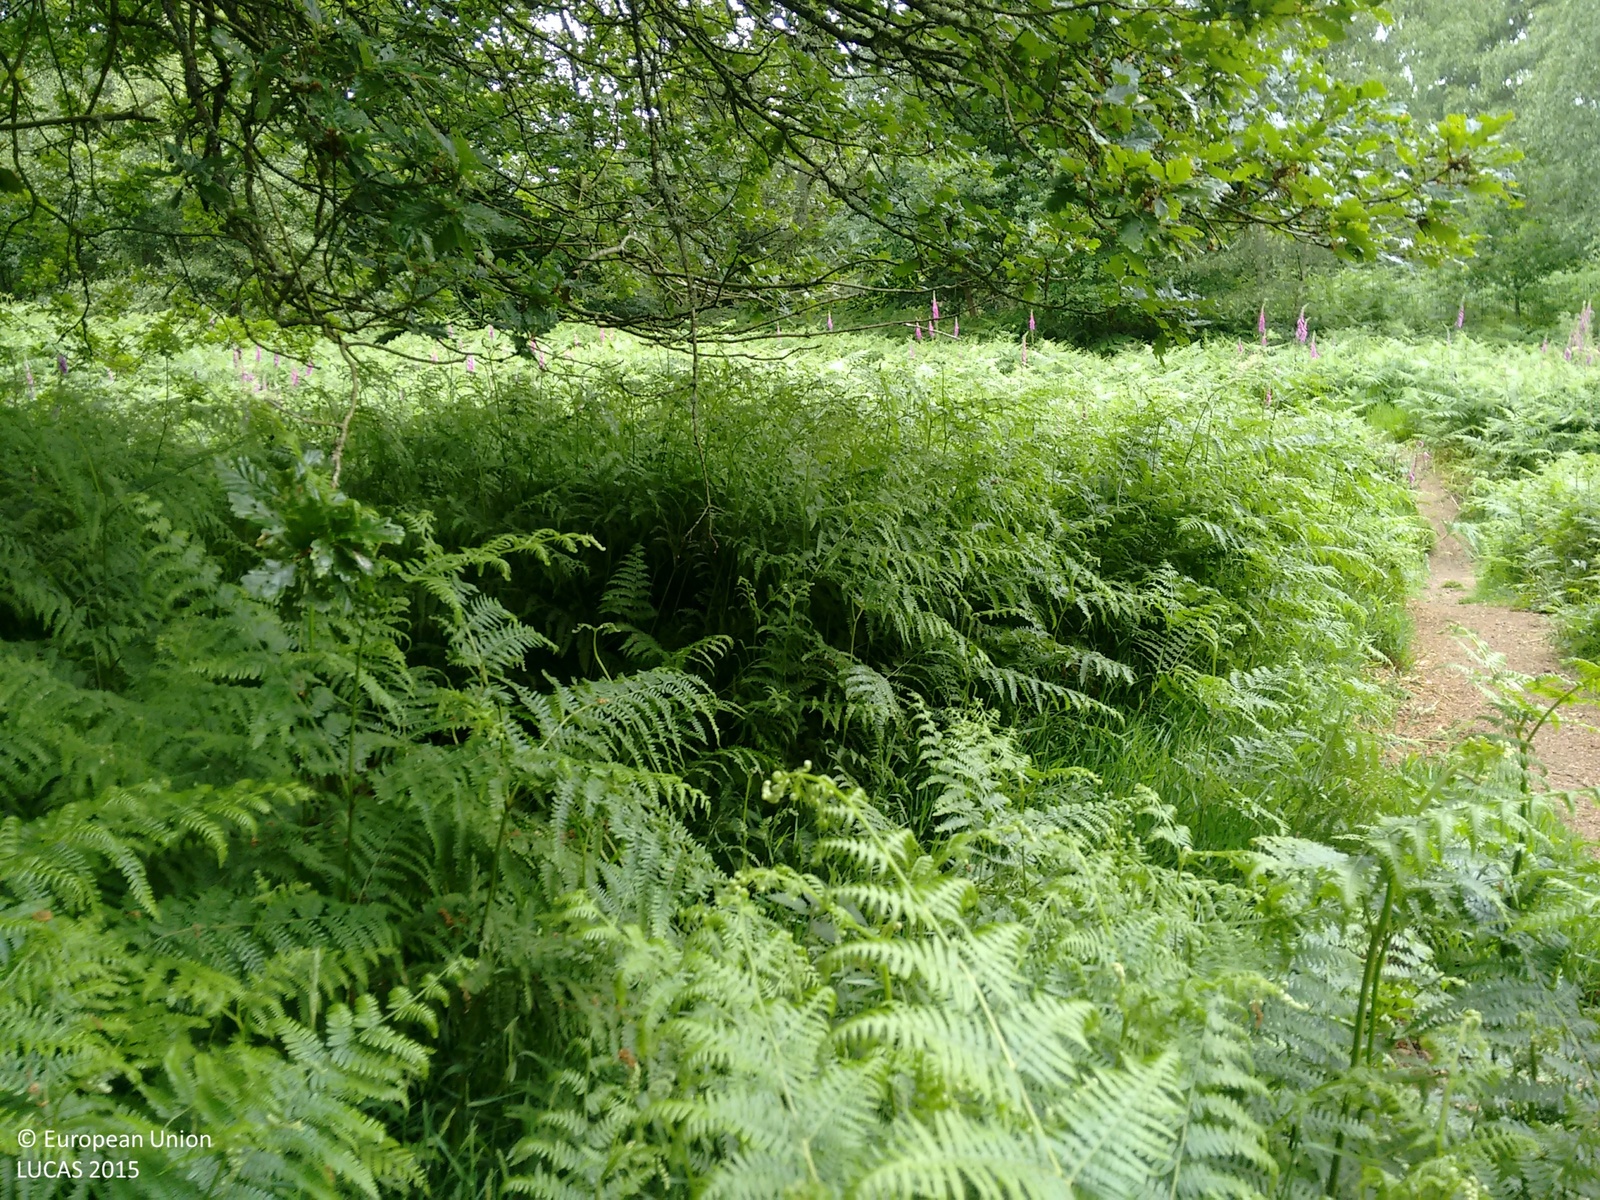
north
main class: Woodland
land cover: Broadleaved woodland
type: mesophytic deciduous forest
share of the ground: > 75 %
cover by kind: broadleaved forest trees 95 %, shrubs 5 %
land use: Semi-natural and natural areas not in use
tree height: > 5 m
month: June
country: GB
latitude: 52.3433
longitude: -2.7380
